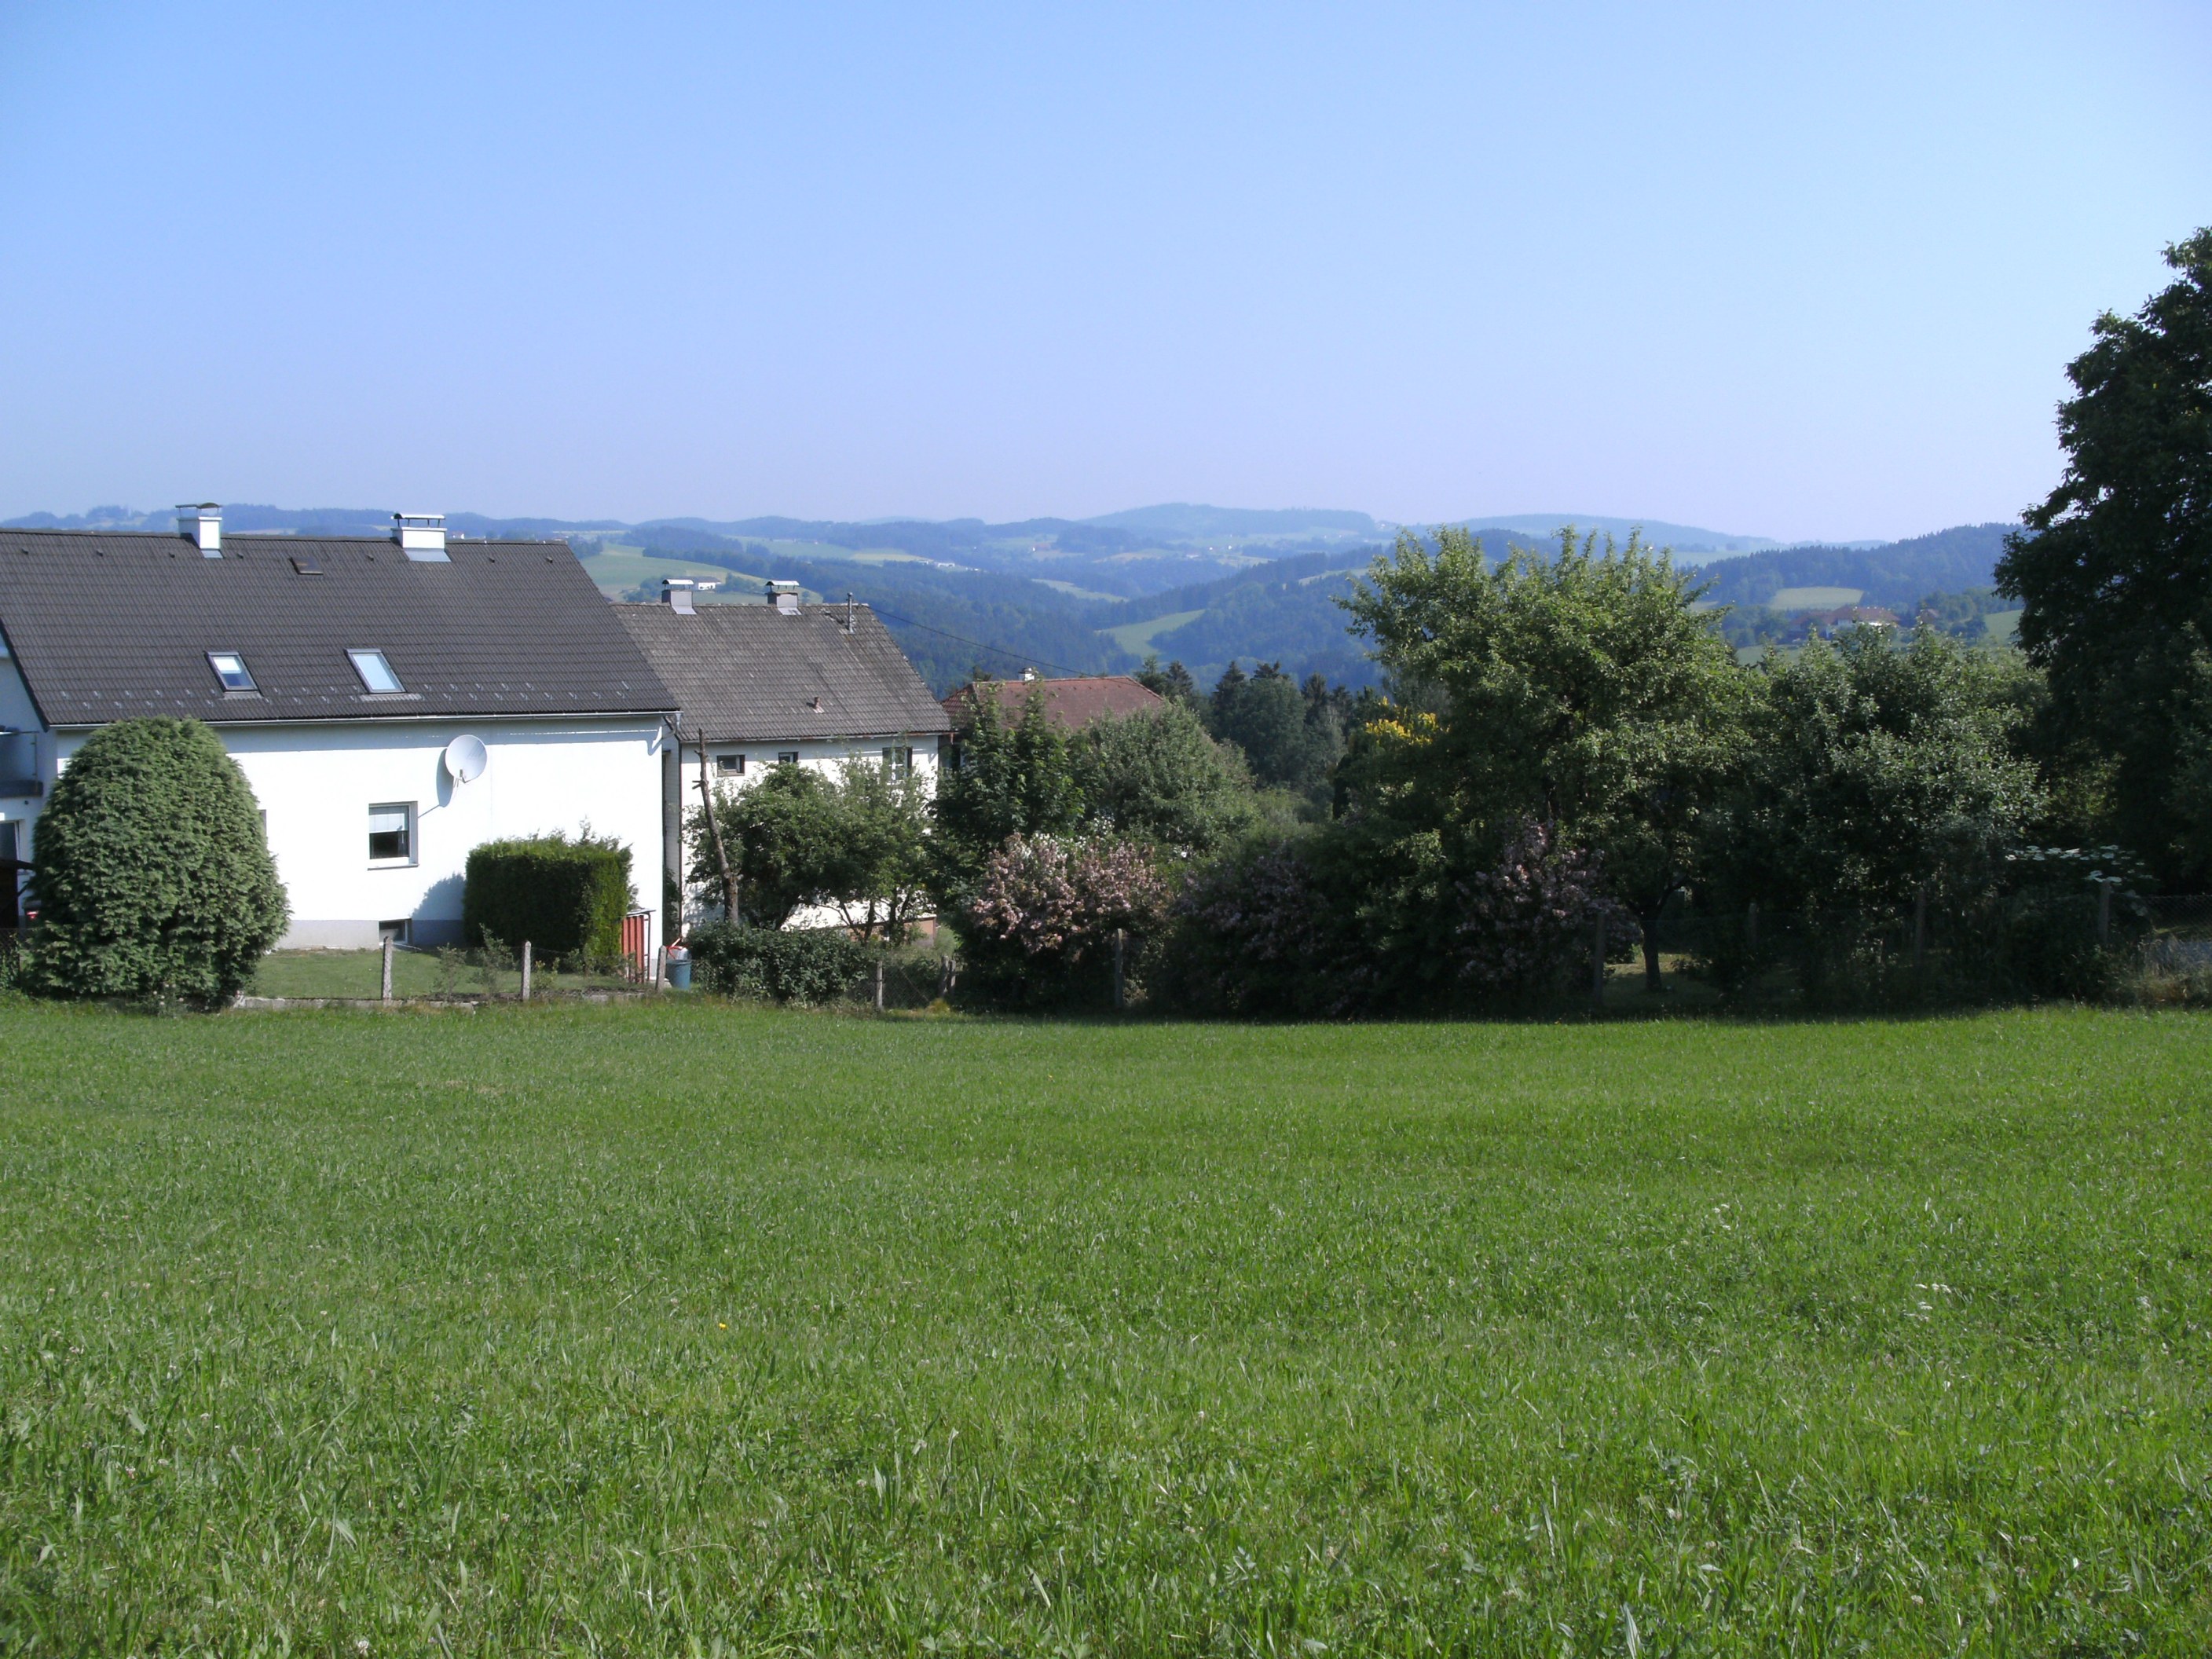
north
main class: Grassland
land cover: Grassland without tree/shrub cover
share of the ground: > 75 %
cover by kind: herbaceous plants 100 %
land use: Agriculture (excluding fallow land and kitchen gardens)
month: June
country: AT
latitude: 48.3778
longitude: 14.1990
